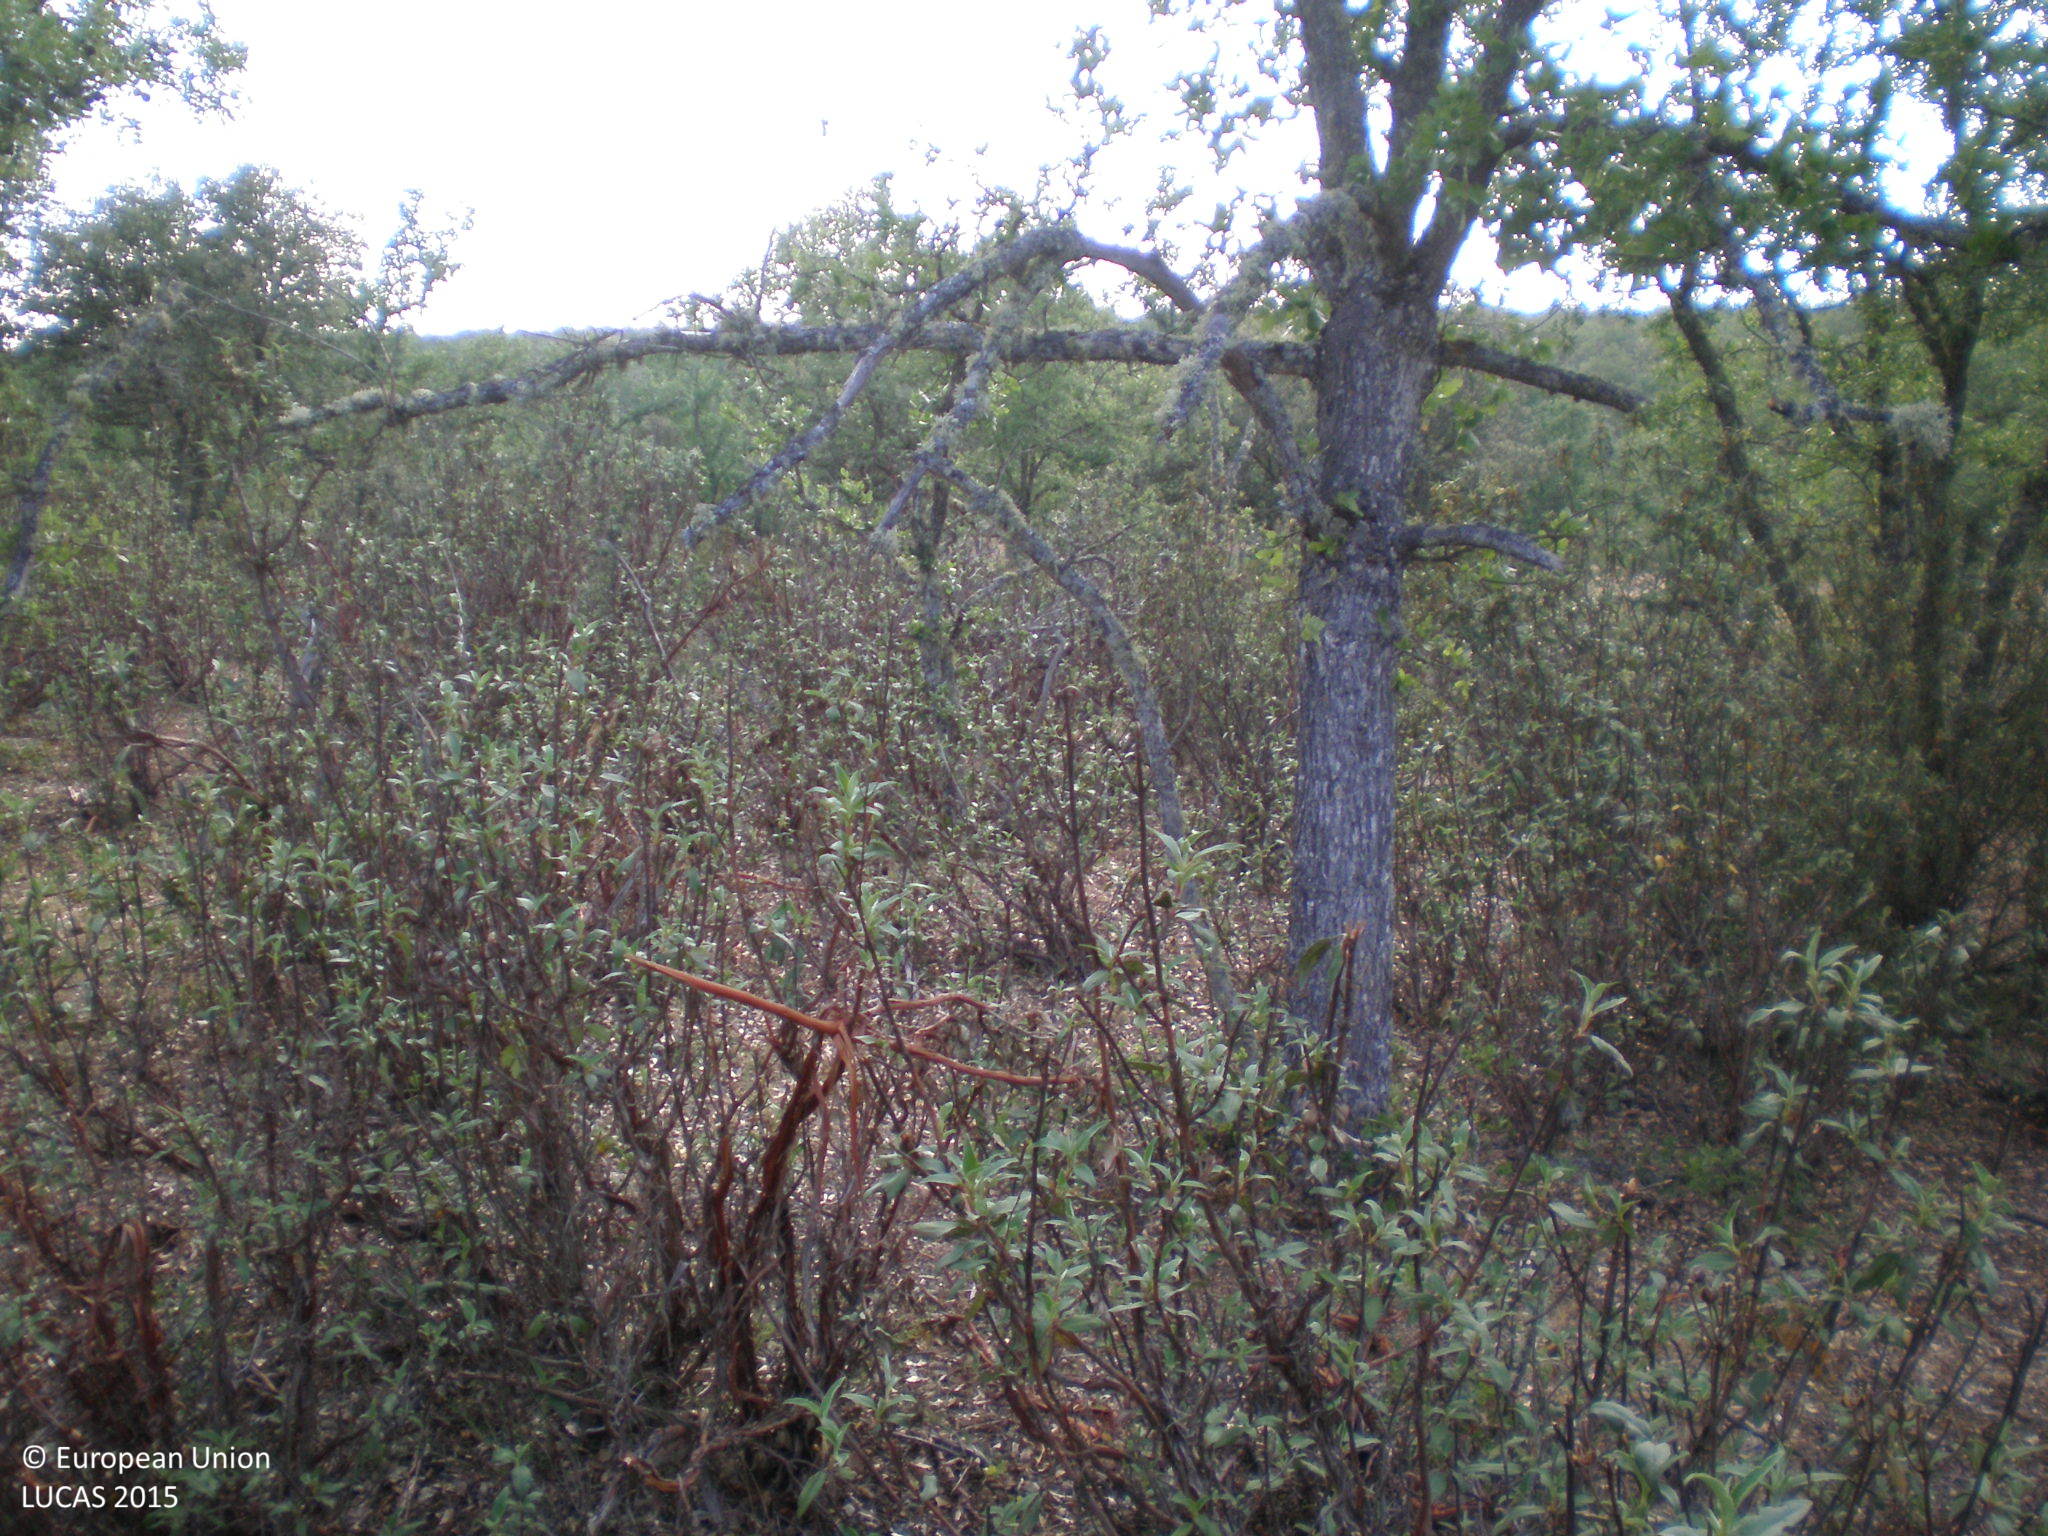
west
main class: Woodland
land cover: Broadleaved woodland
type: broadleaved evergreen forest
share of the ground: > 75 %
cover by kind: broadleaved forest trees 90 %, herbaceous plants 10 %
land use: Forestry
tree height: > 5 m
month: June
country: ES
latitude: 41.2296
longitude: -5.7467
